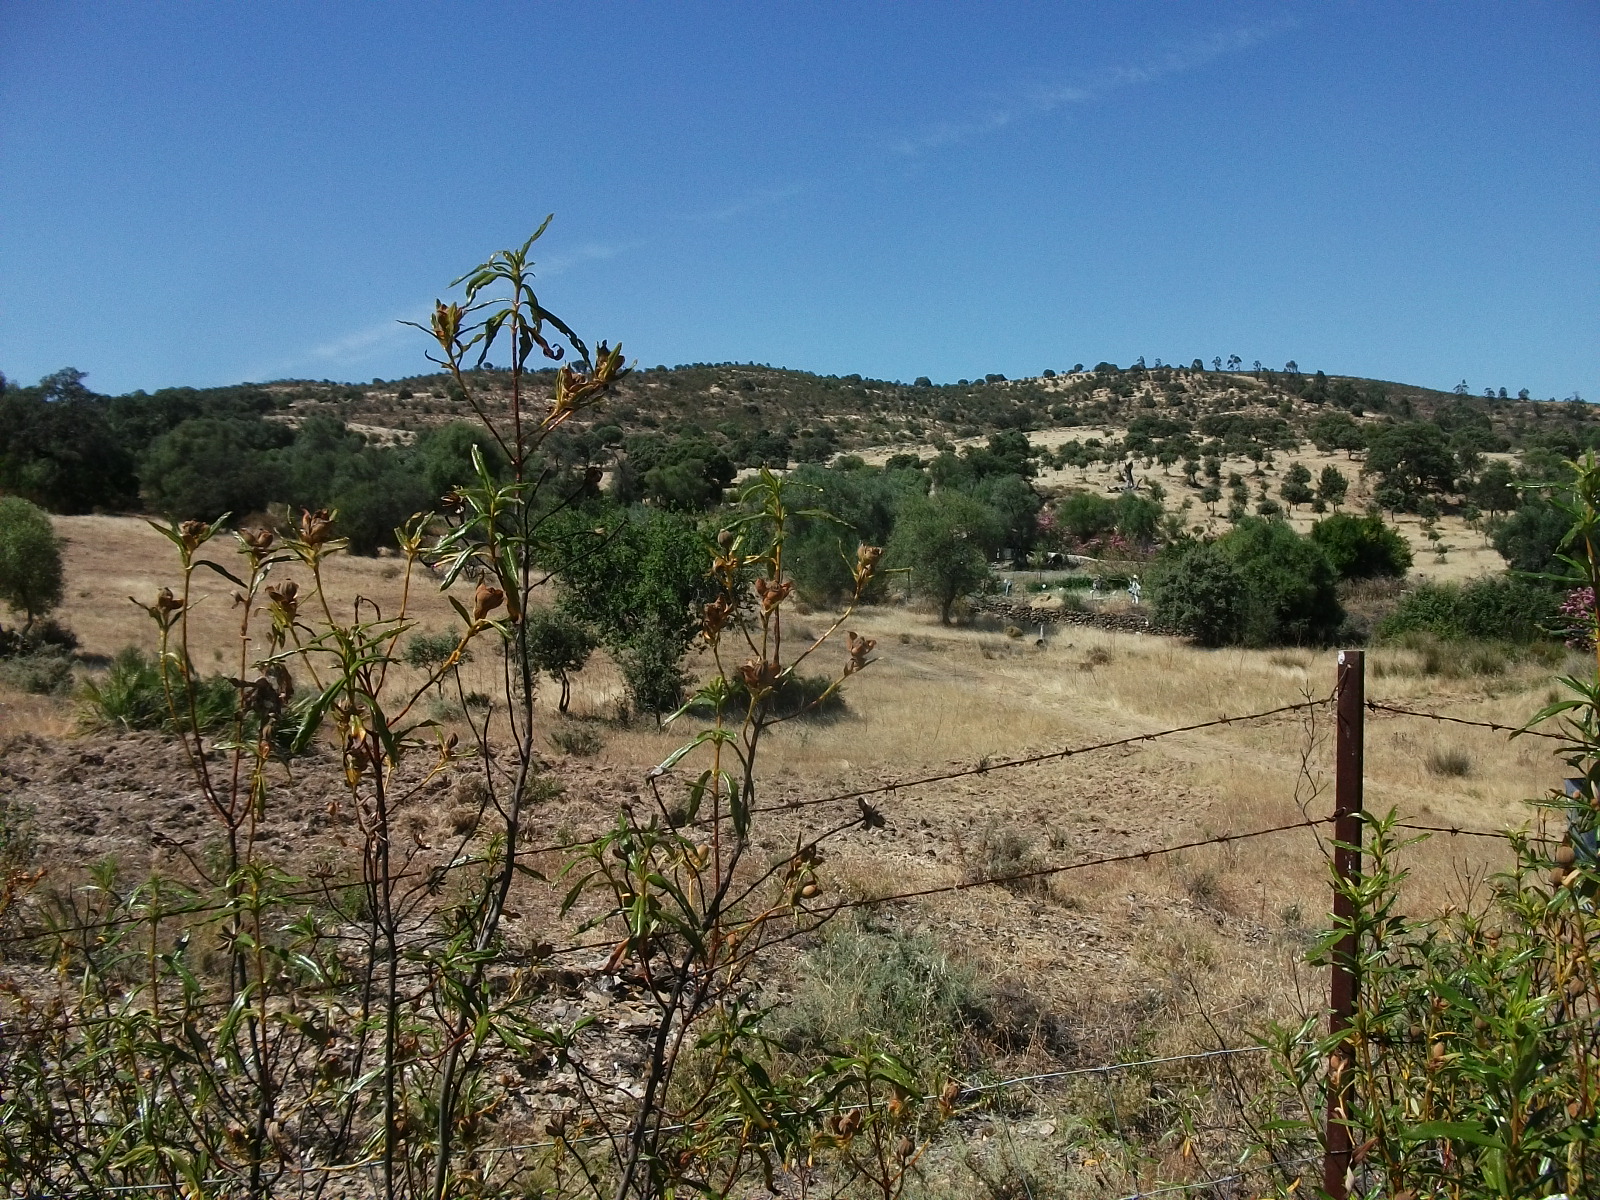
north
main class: Woodland
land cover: Broadleaved woodland
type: broadleaved evergreen forest
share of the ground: > 75 %
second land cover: Spontaneously vegetated surfaces
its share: < 10 %
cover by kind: broadleaved forest trees 80 %, shrubs 10 %, herbaceous plants 10 %
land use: Forestry
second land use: Agriculture (excluding fallow land and kitchen gardens)
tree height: > 5 m
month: June
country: ES
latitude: 37.7179
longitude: -7.0088
